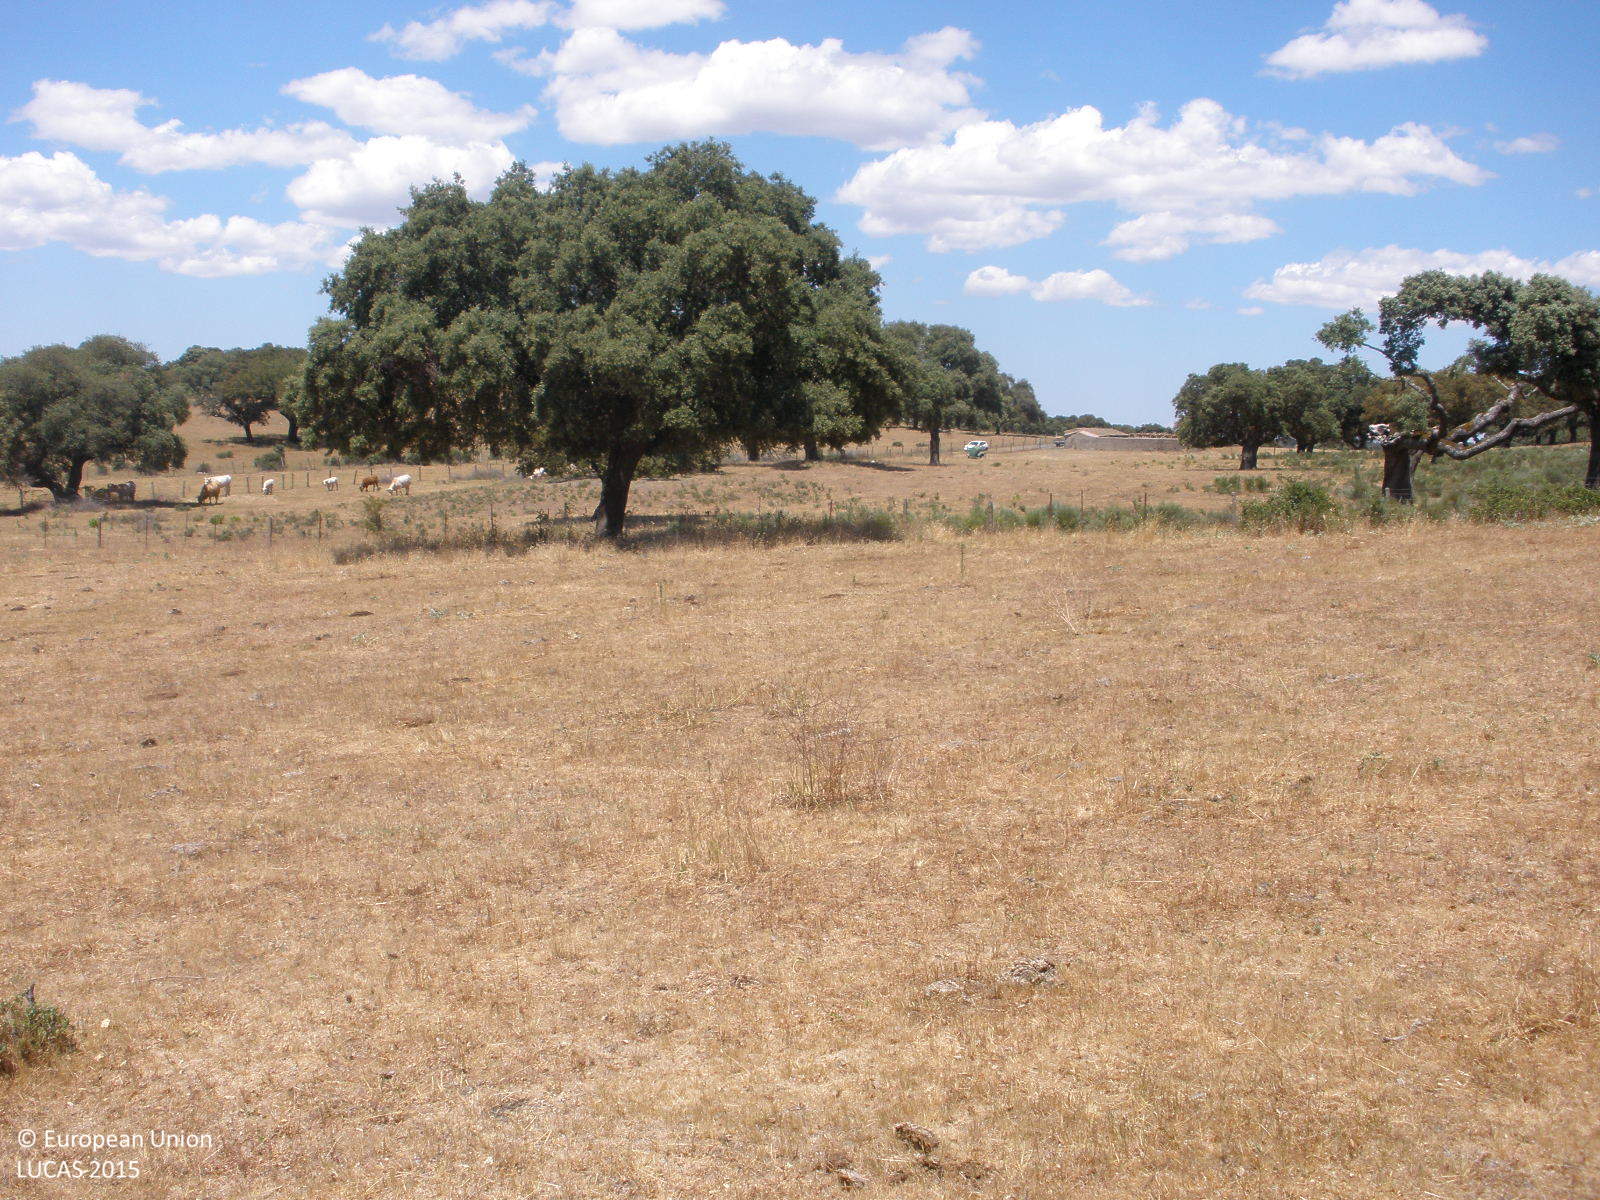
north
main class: Woodland
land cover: Broadleaved woodland
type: broadleaved evergreen forest
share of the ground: 25 - 50 %
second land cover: Grassland without tree/shrub cover
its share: > 75 %
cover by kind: herbaceous plants 60 %, broadleaved forest trees 30 %, shrubs 10 %
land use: Forestry
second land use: Agriculture (excluding fallow land and kitchen gardens)
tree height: > 5 m
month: June
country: ES
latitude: 40.4669
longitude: -6.6852
